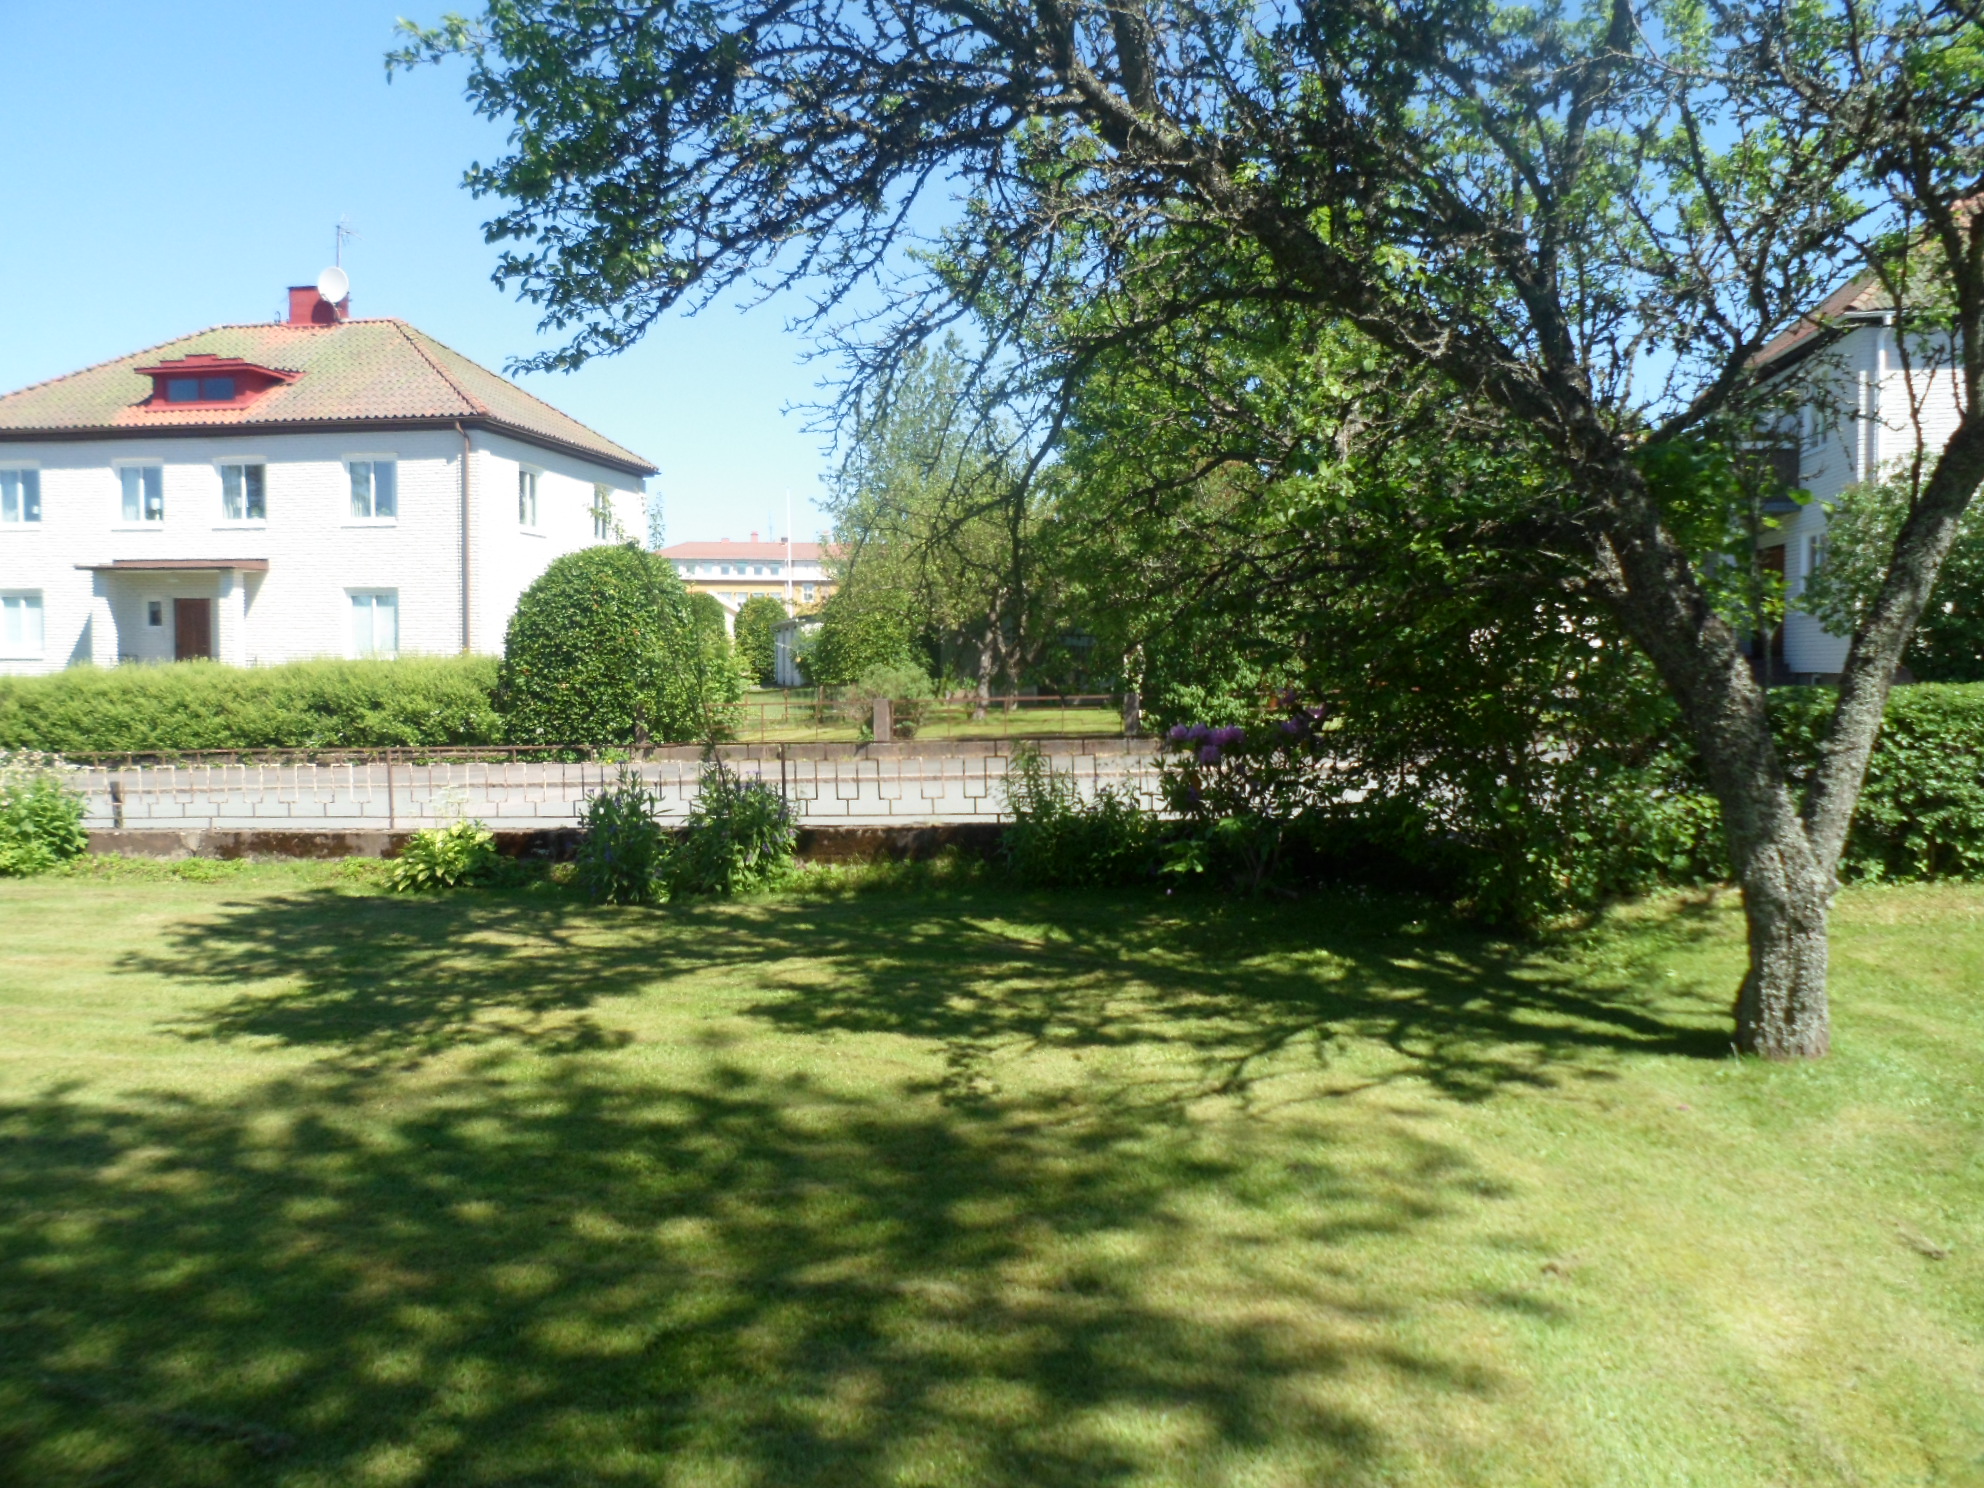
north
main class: Grassland
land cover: Grassland with sparse tree/shrub cover
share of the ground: > 75 %
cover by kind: herbaceous plants 95 %, broadleaved forest trees 5 %
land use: Residential
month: July
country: SE
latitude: 57.3996
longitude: 14.6723
